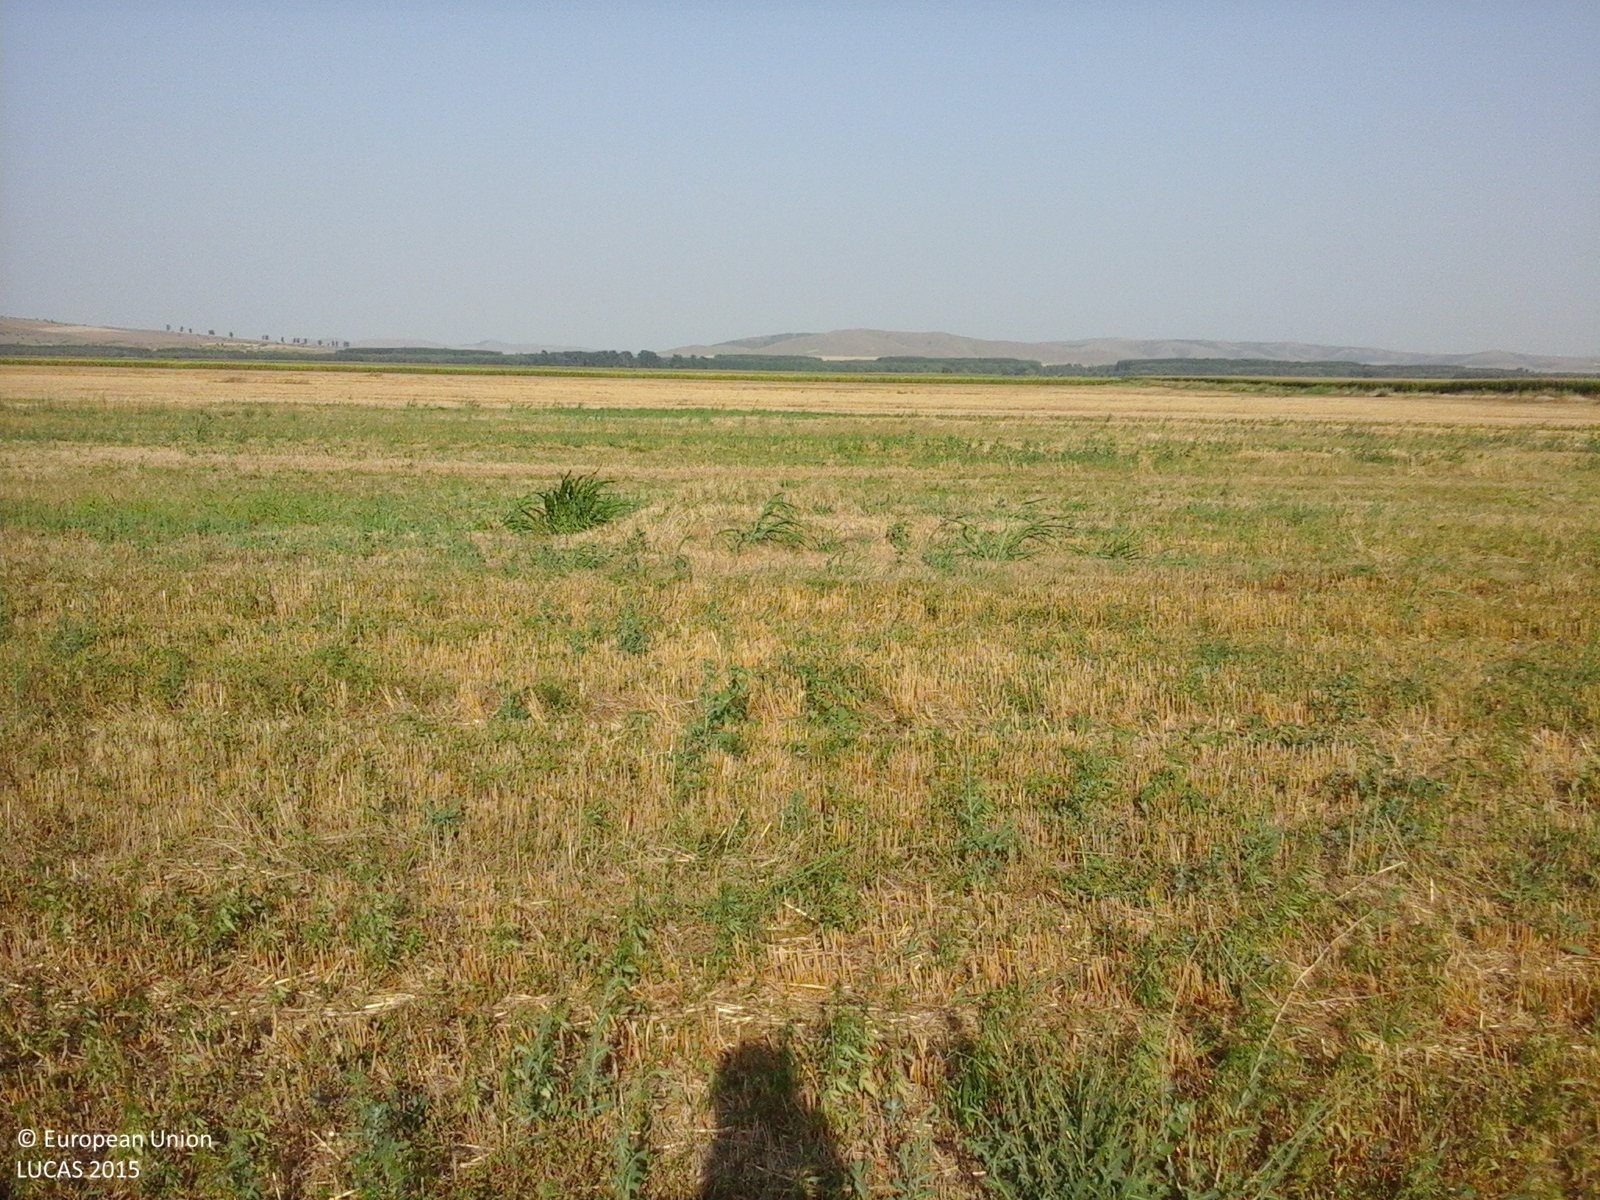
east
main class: Cropland
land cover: Barley
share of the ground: 50 - 75 %
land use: Agriculture (excluding fallow land and kitchen gardens)
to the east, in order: Barley
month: August
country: RO
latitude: 44.9731
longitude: 28.1088
